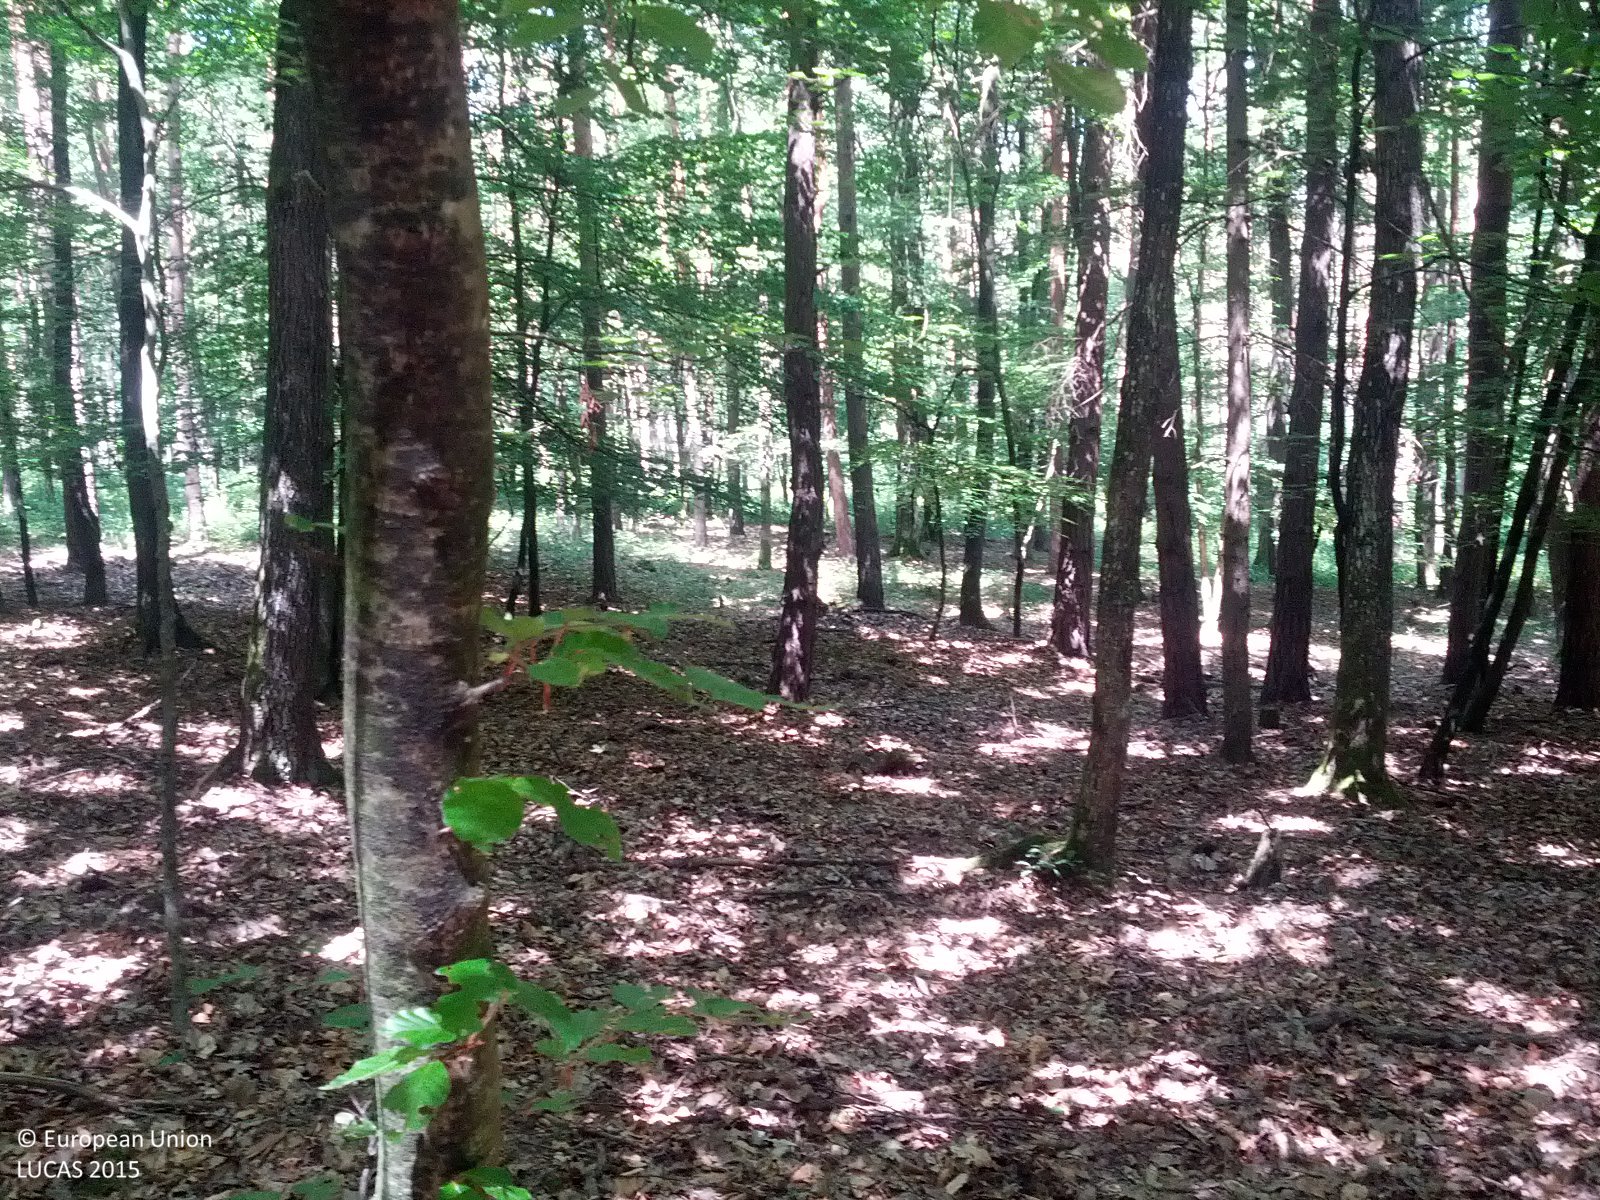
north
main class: Woodland
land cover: Pine dominated mixed woodland
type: hemiboreal forest and nemoral coniferous forest and mixed broadleaved-coniferous forest
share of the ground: > 75 %
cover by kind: coniferous forest trees 50 %, broadleaved forest trees 50 %
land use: Forestry
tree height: > 5 m
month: June
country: AT
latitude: 47.1530
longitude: 16.3991
